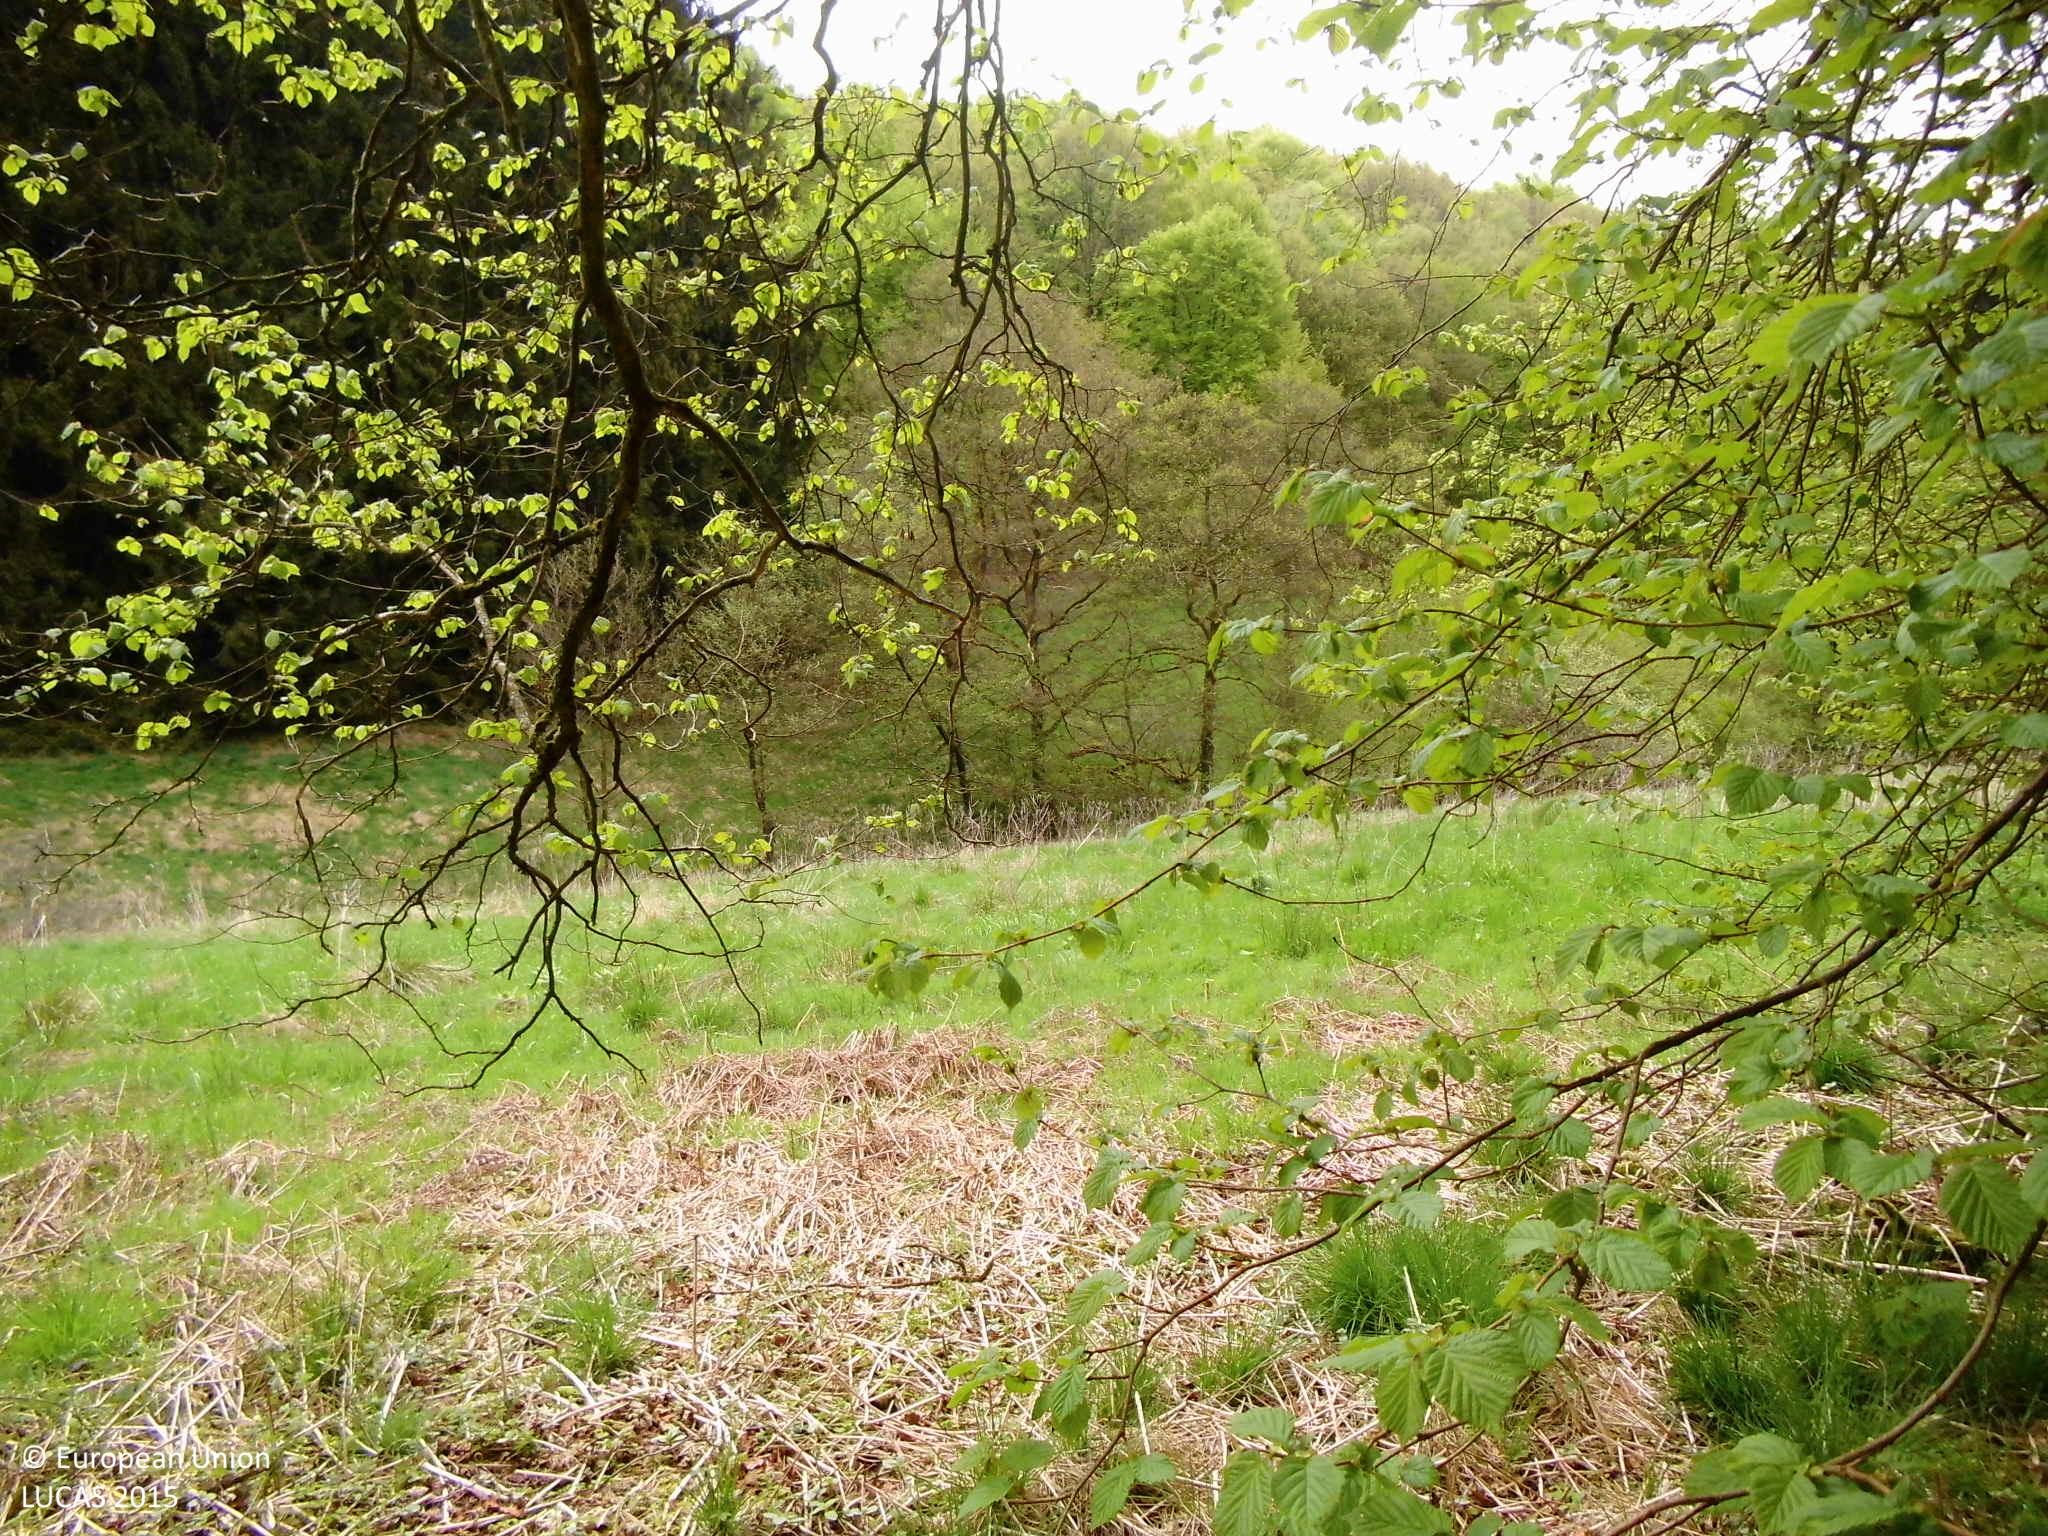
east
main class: Grassland
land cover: Grassland without tree/shrub cover
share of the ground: > 75 %
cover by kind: herbaceous plants 75 %, unconsolidated bare surface 20 %, shrubs 5 %
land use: Agriculture (excluding fallow land and kitchen gardens)
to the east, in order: Grassland without tree/shrub cover; Broadleaved woodland; Rivers and streams; Broadleaved woodland; Fences; Grassland without tree/shrub cover; Fences; Broadleaved woodland; Tracks; Broadleaved woodland; Spruce dominated coniferous woodland
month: May
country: DE
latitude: 51.2540
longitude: 7.4928
